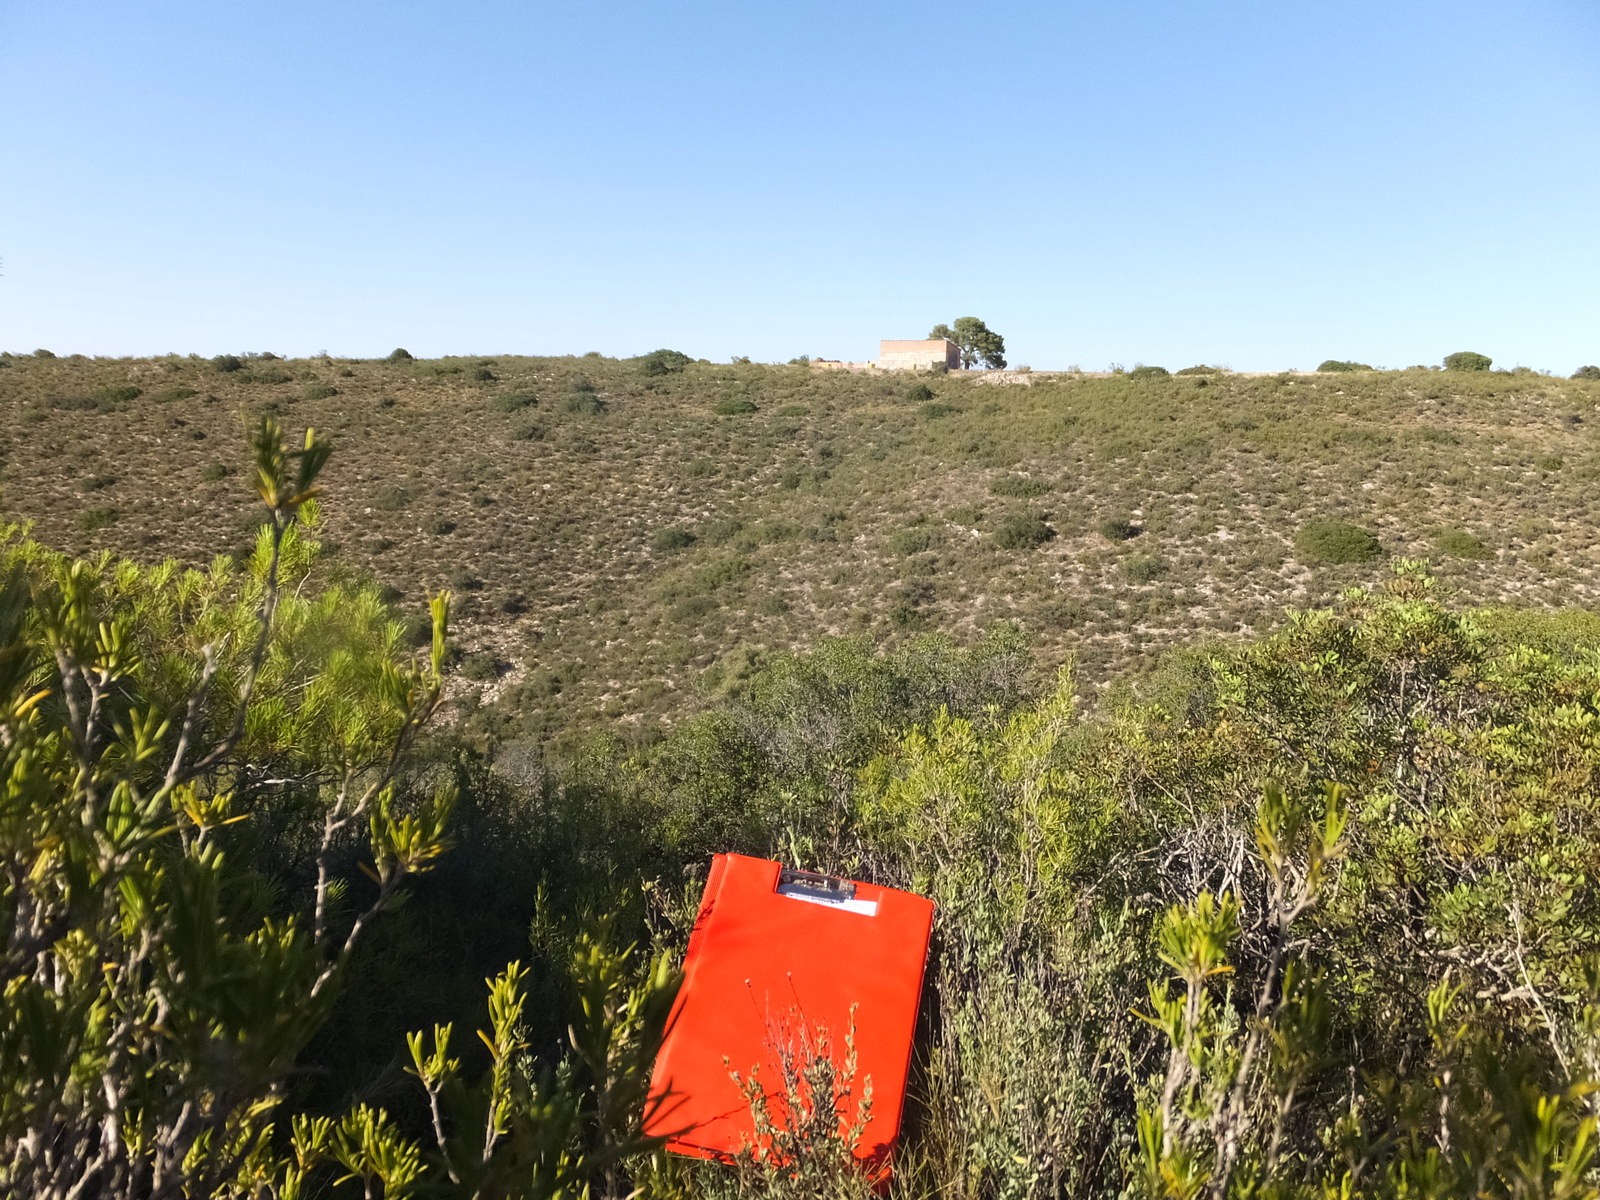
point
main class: Shrubland
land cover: Shrubland with sparse tree cover
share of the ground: > 75 %
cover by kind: shrubs 75 %, herbaceous plants 20 %, coniferous forest trees 5 %
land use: Semi-natural and natural areas not in use
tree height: < 5 m
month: July
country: ES
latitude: 41.4128
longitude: 0.1891
